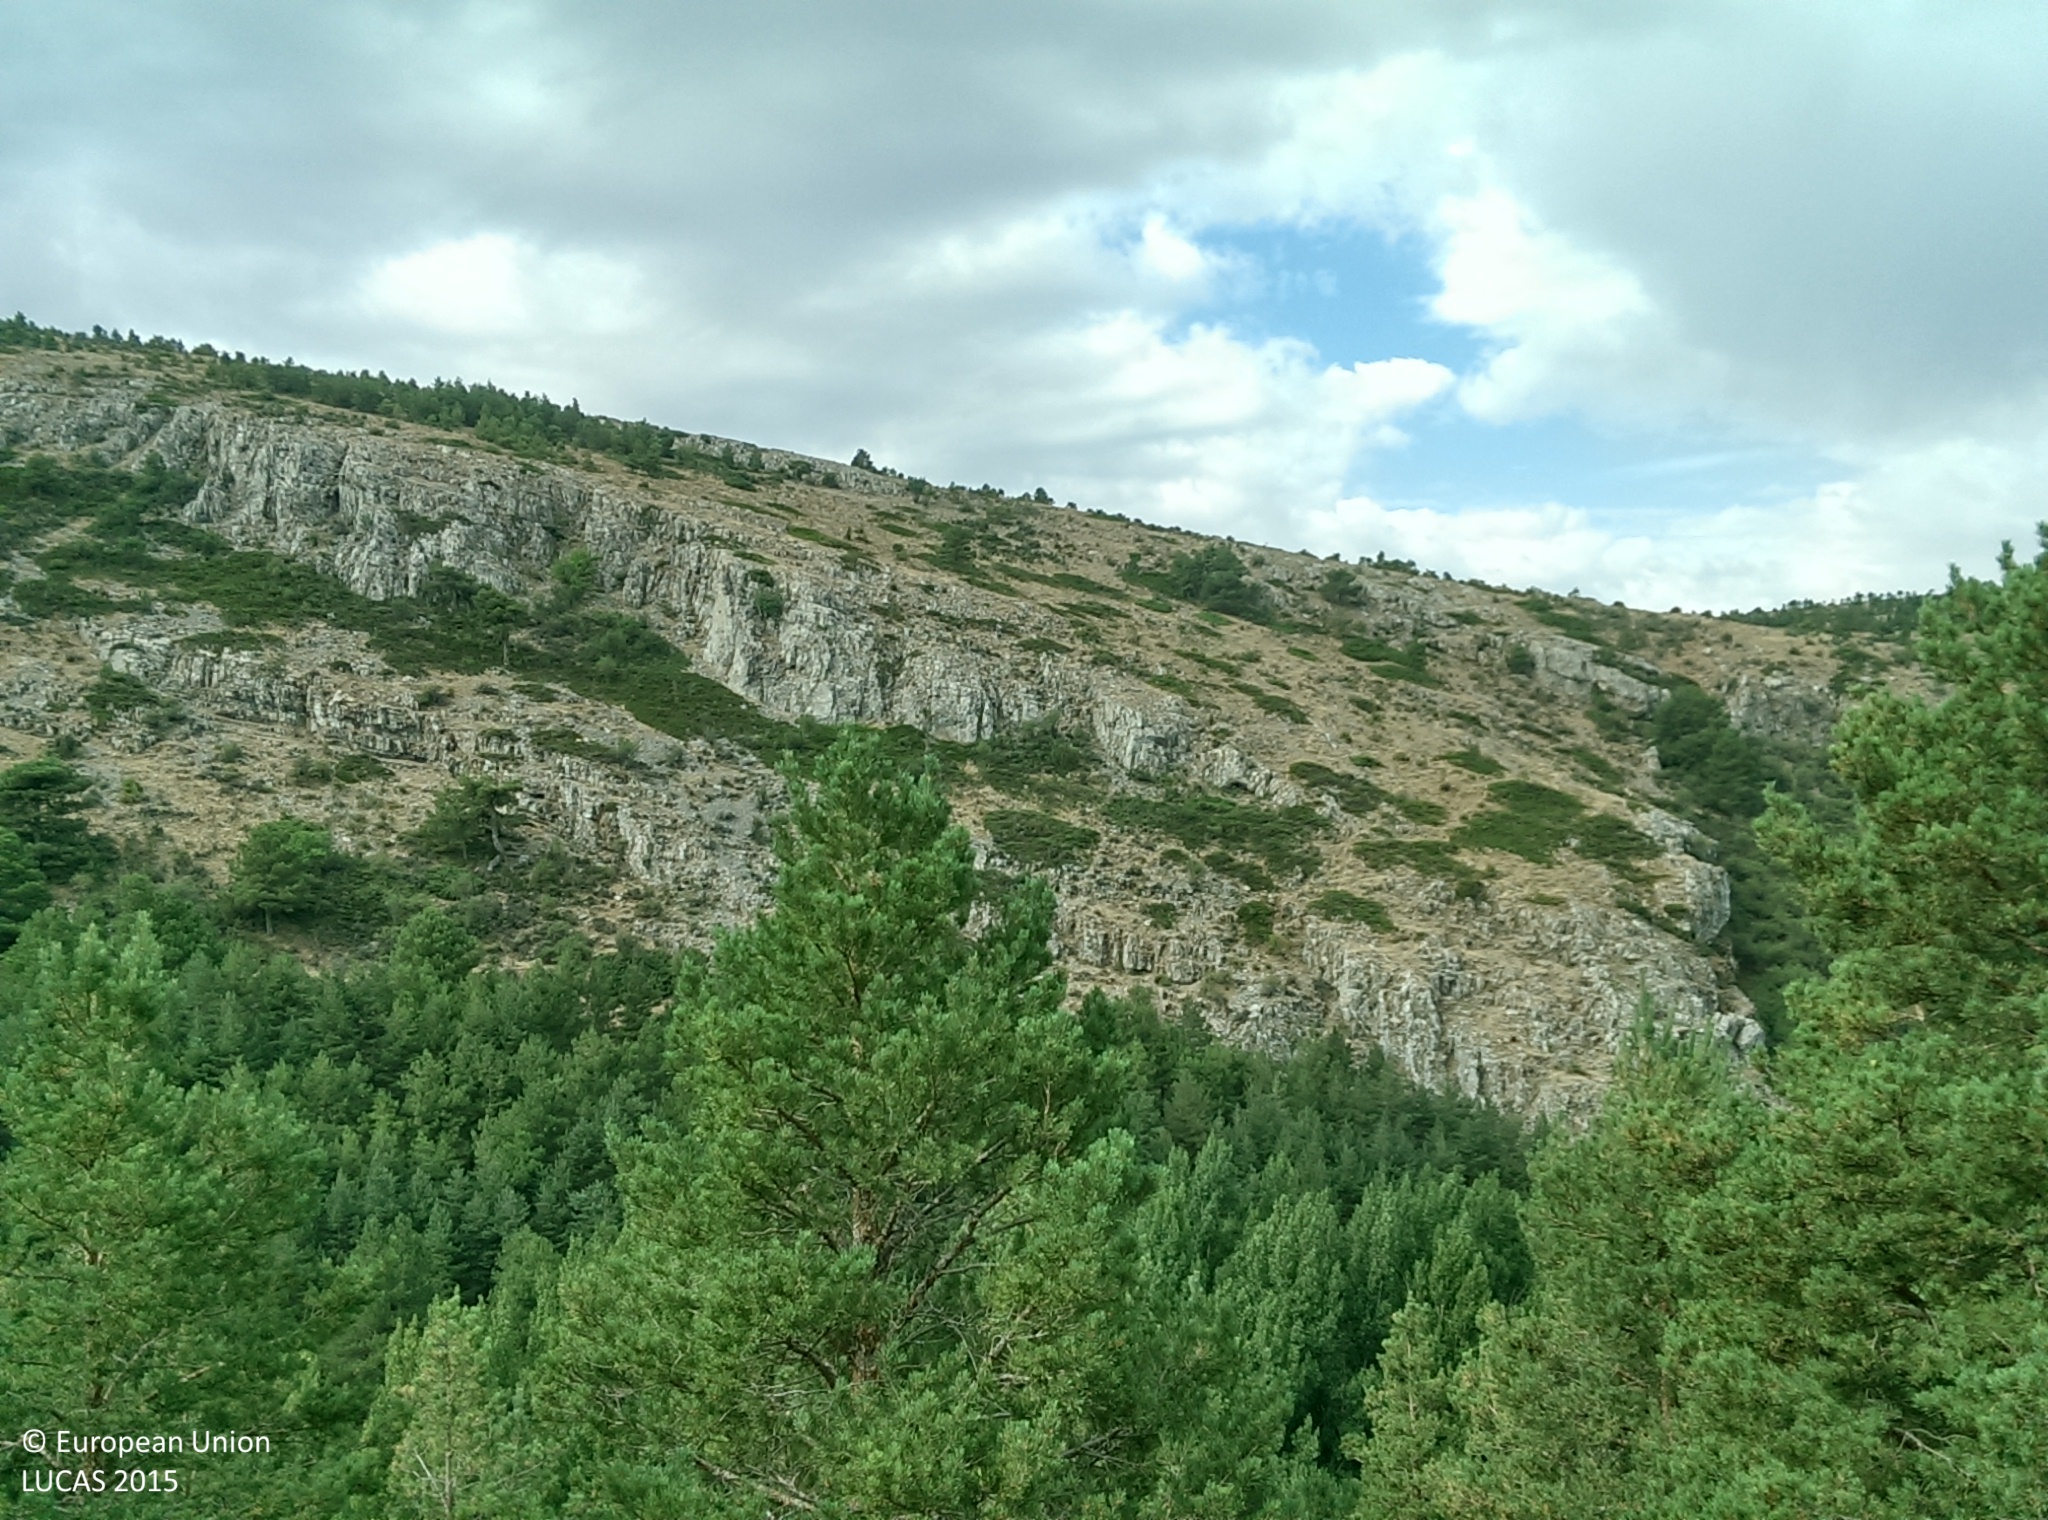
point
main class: Woodland
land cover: Pine dominated coniferous woodland
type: coniferous forest of the mediterranean region
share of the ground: 10 - 25 %
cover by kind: shrubs 40 %, herbaceous plants 20 %, coniferous forest trees 15 %, consolidated bare surface 15 %, unconsolidated bare surface 10 %
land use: Forestry
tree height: > 5 m
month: July
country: ES
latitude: 37.3077
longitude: -2.8812
